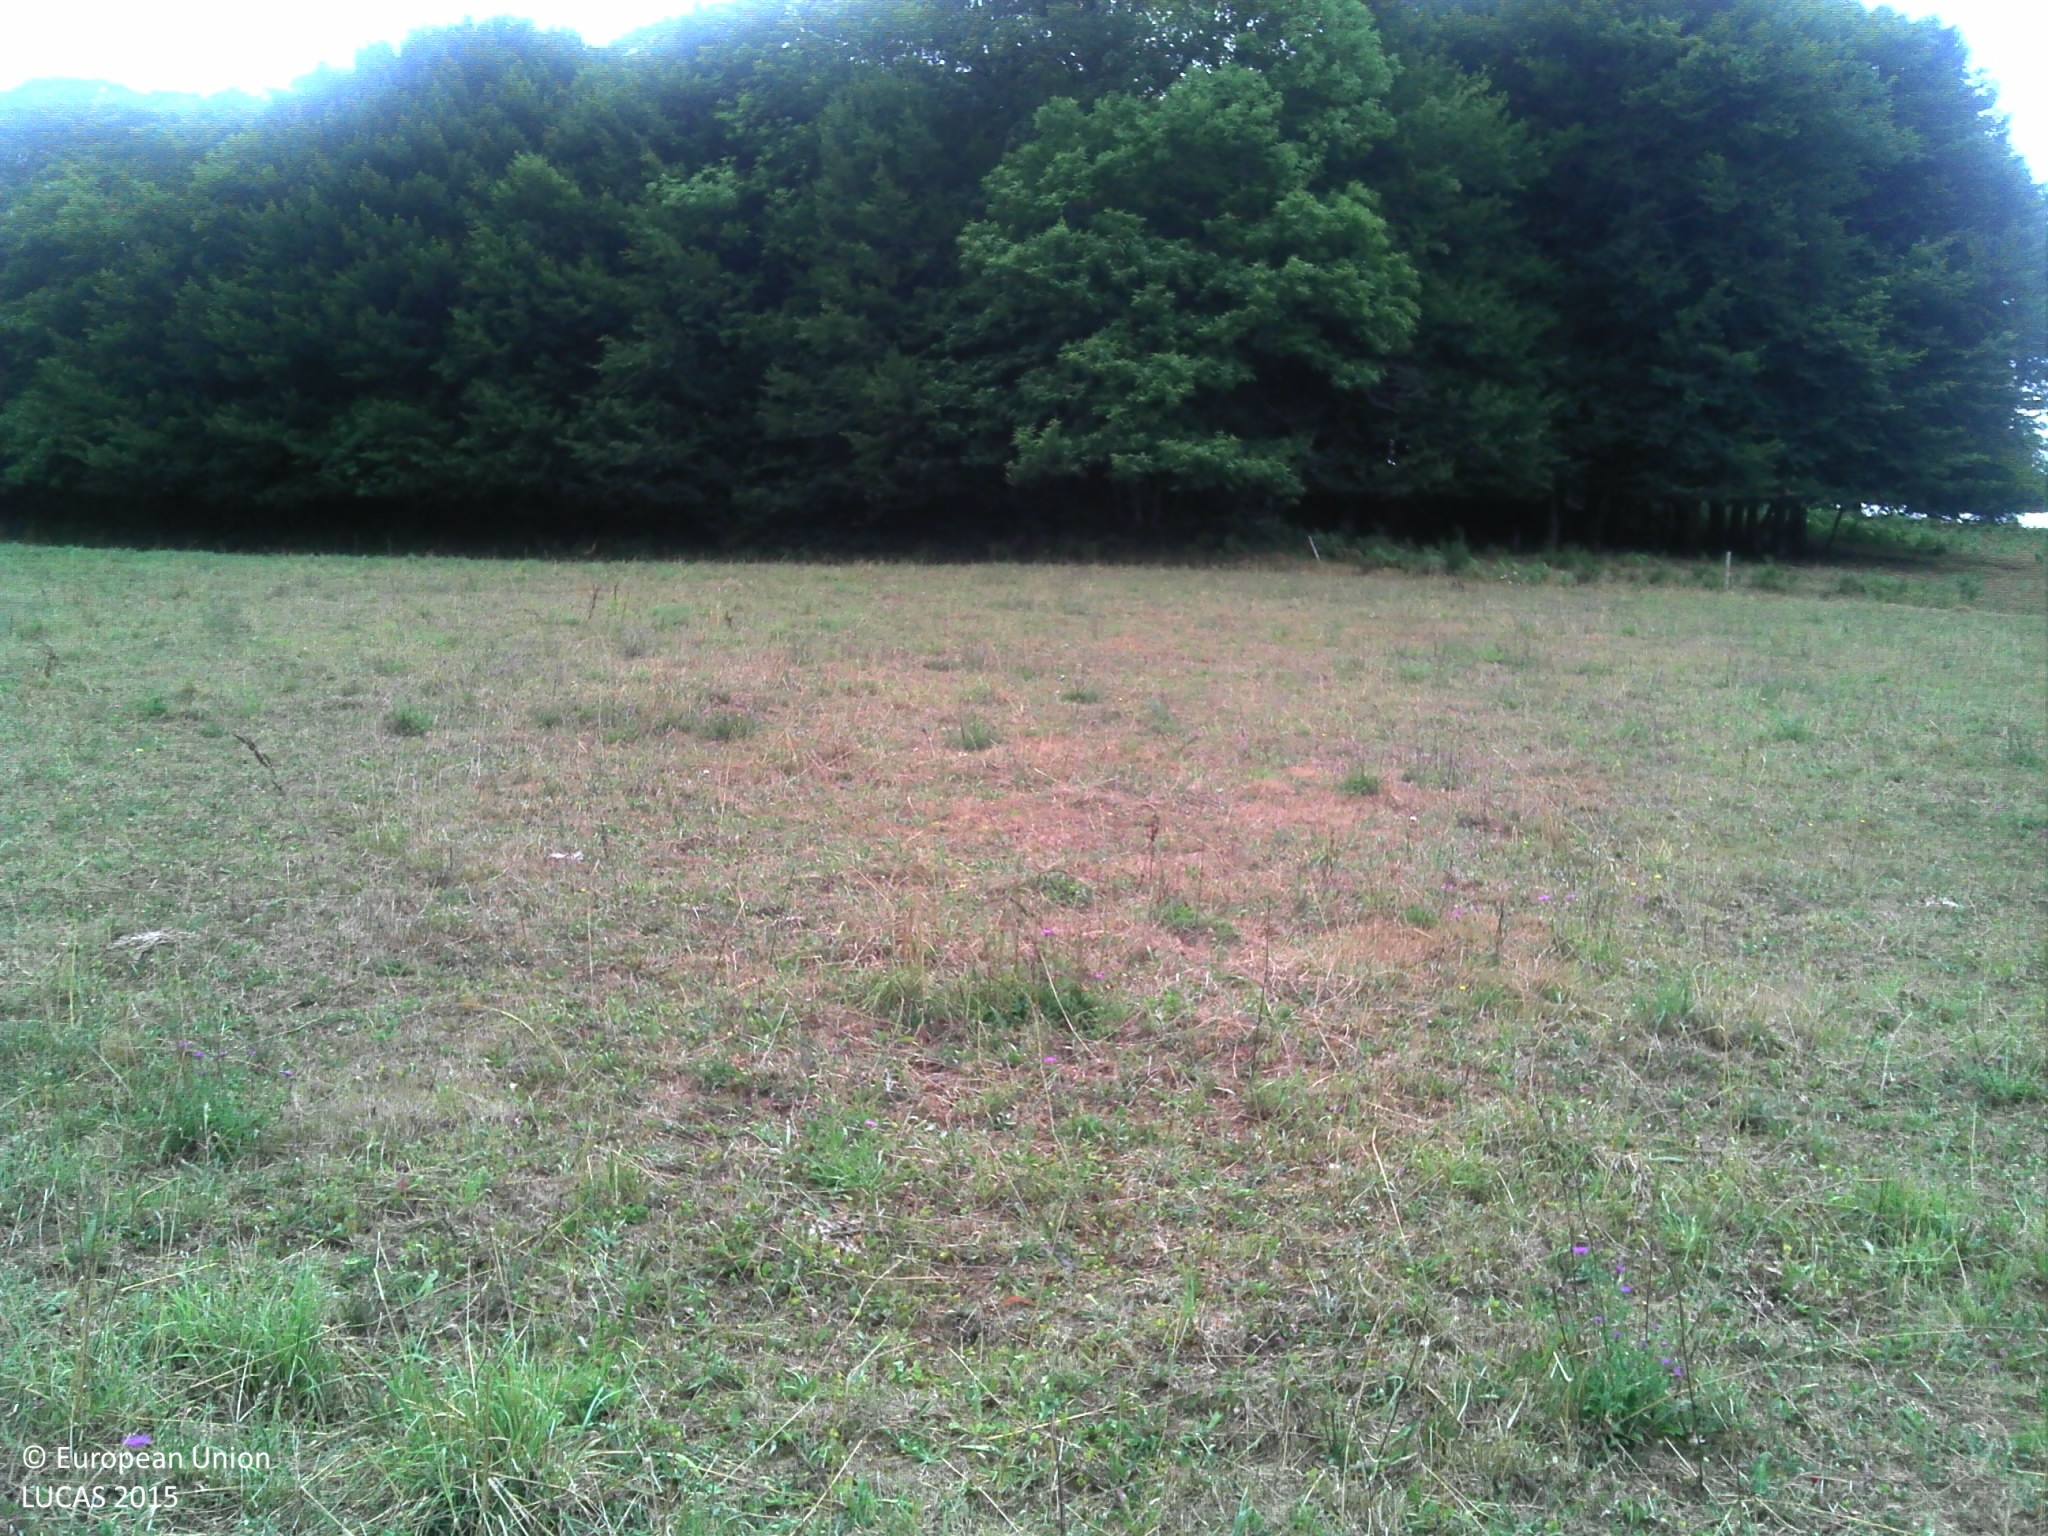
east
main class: Grassland
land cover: Grassland without tree/shrub cover
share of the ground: > 75 %
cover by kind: herbaceous plants 95 %, shrubs 5 %
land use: Agriculture (excluding fallow land and kitchen gardens)
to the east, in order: Grassland without tree/shrub cover; Fences; Broadleaved woodland; Fences; Grassland without tree/shrub cover; Fences; Lines of trees; Grass margins; Ditches and canals; Grass margins; Paved roads, cycling and walking lanes; Grass margins; Broadleaved woodland
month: July
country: FR
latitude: 45.3608
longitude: 1.5047
